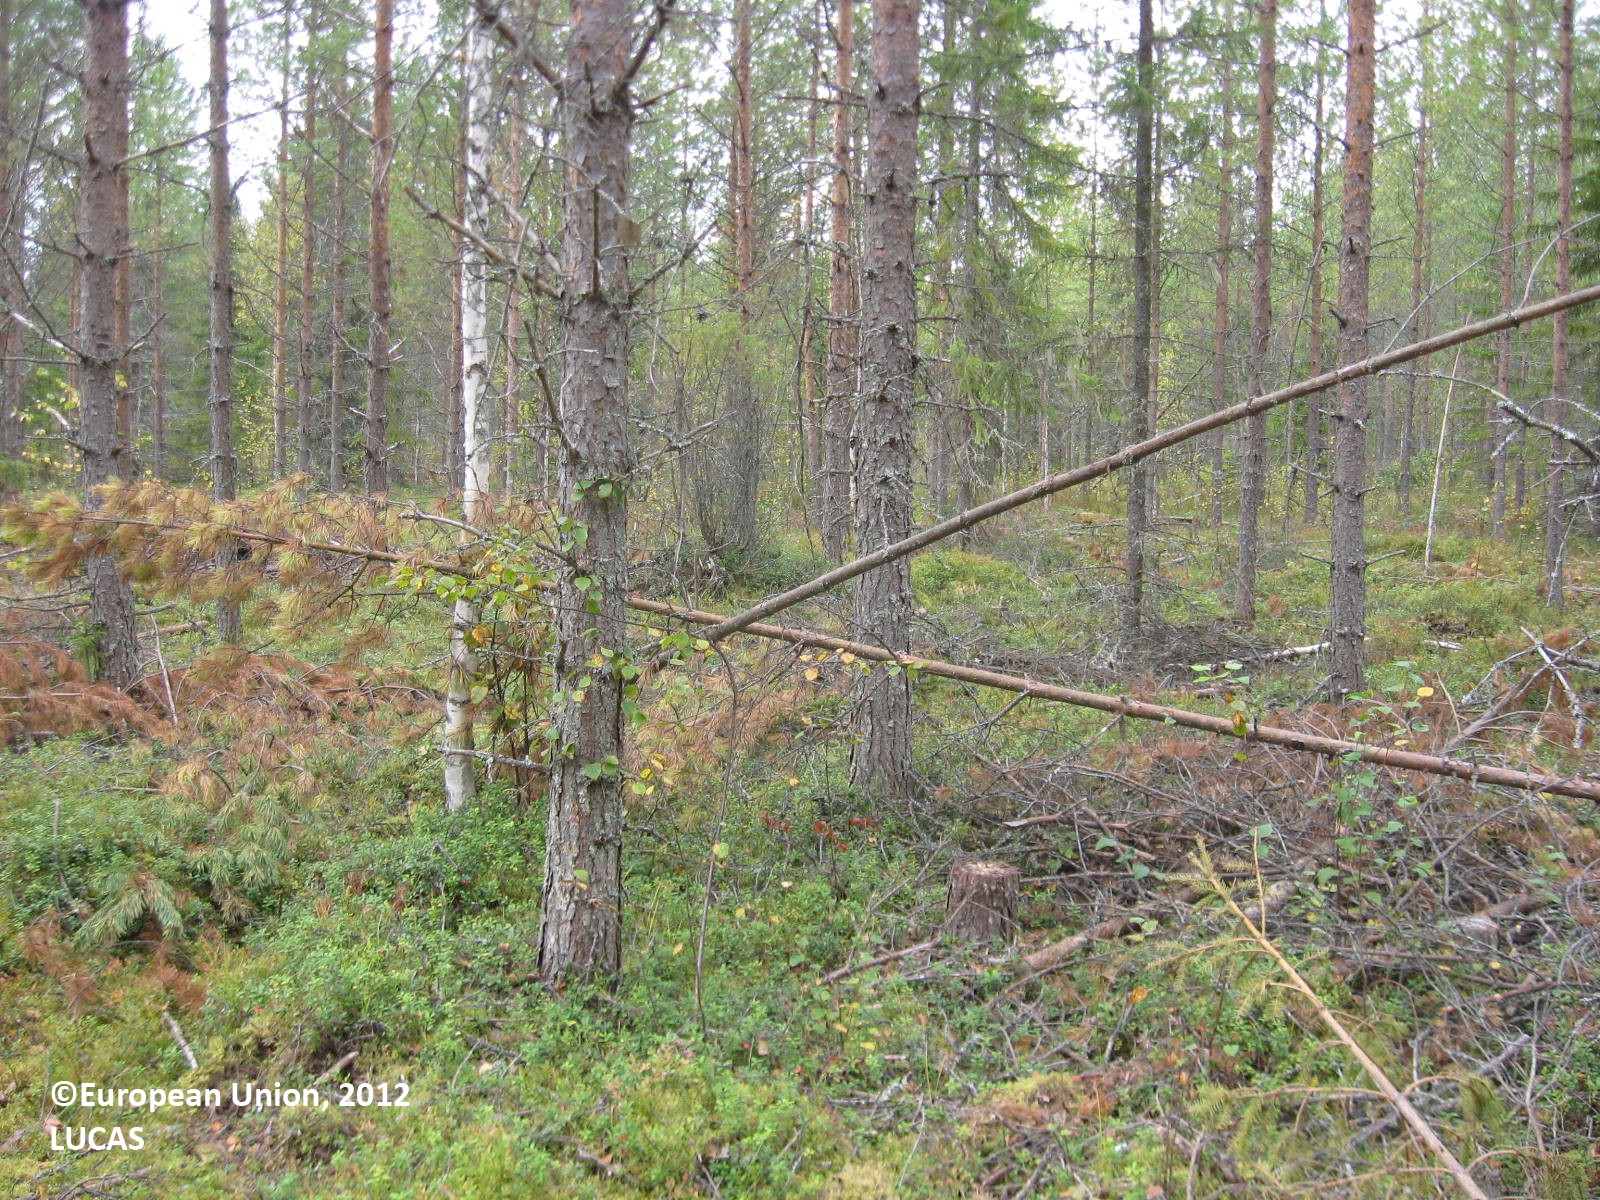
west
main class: Woodland
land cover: Pine dominated coniferous woodland
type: boreal forest
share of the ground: > 75 %
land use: Forestry
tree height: > 5 m
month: September
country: FI
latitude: 64.0809
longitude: 28.3226
